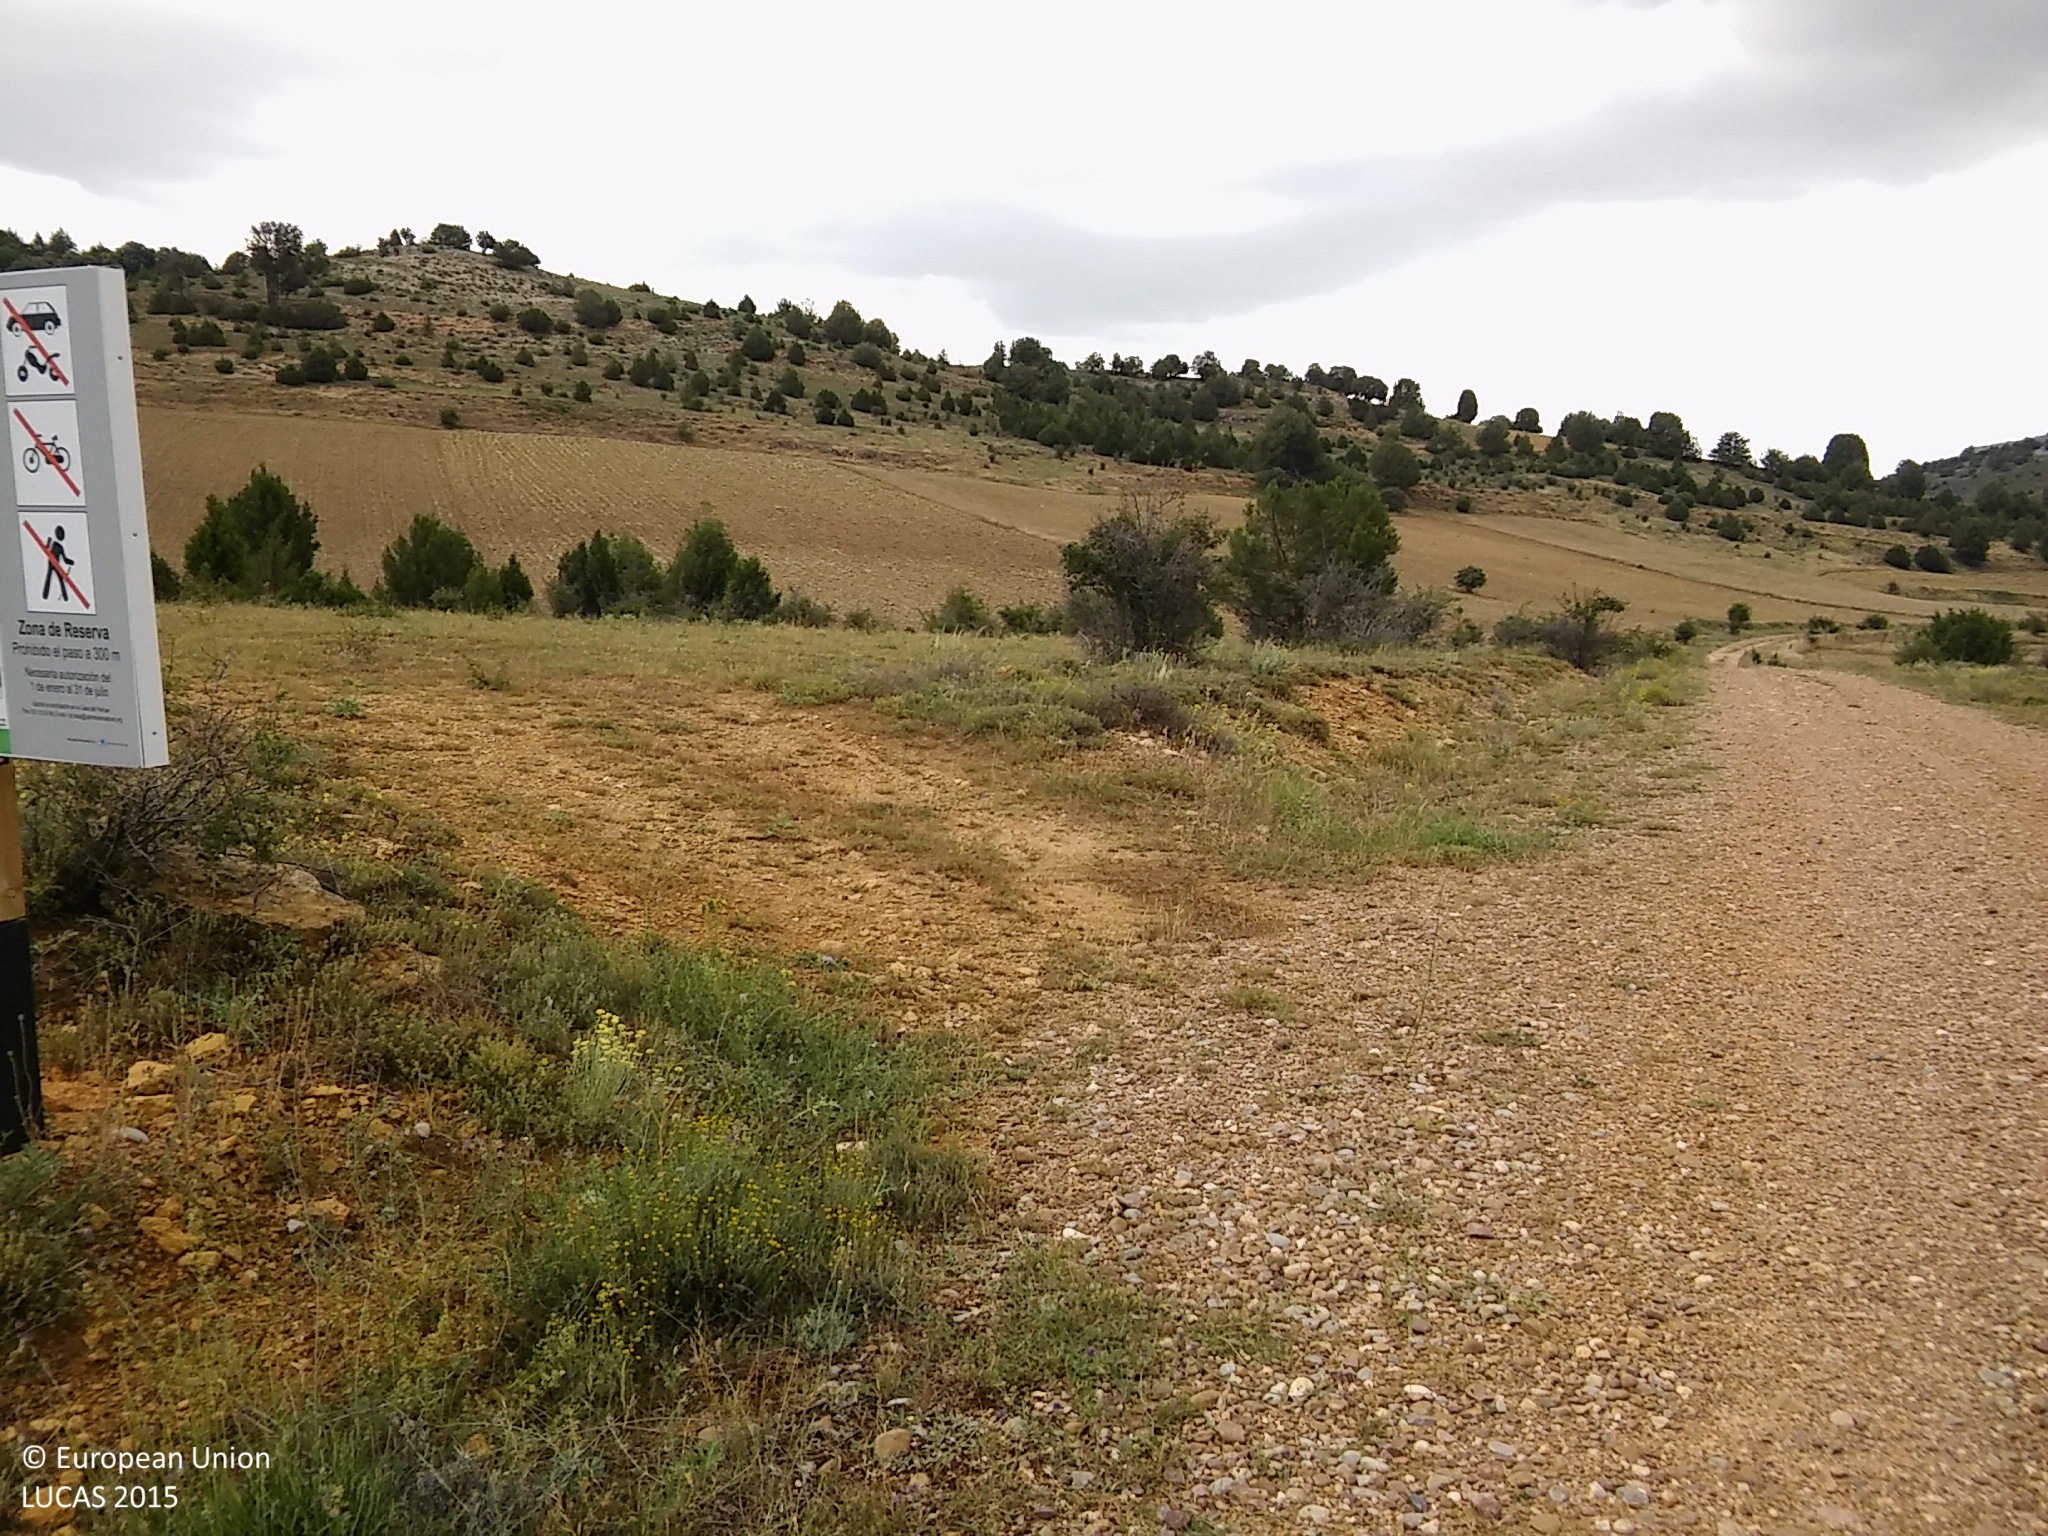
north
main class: Woodland
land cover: Other coniferous woodland
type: coniferous forest of the mediterranean region
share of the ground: 25 - 50 %
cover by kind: coniferous forest trees 30 %, herbaceous plants 25 %, unconsolidated bare surface 25 %, shrubs 20 %
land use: Forestry
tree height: > 5 m
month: June
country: ES
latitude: 41.5300
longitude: -3.6050
